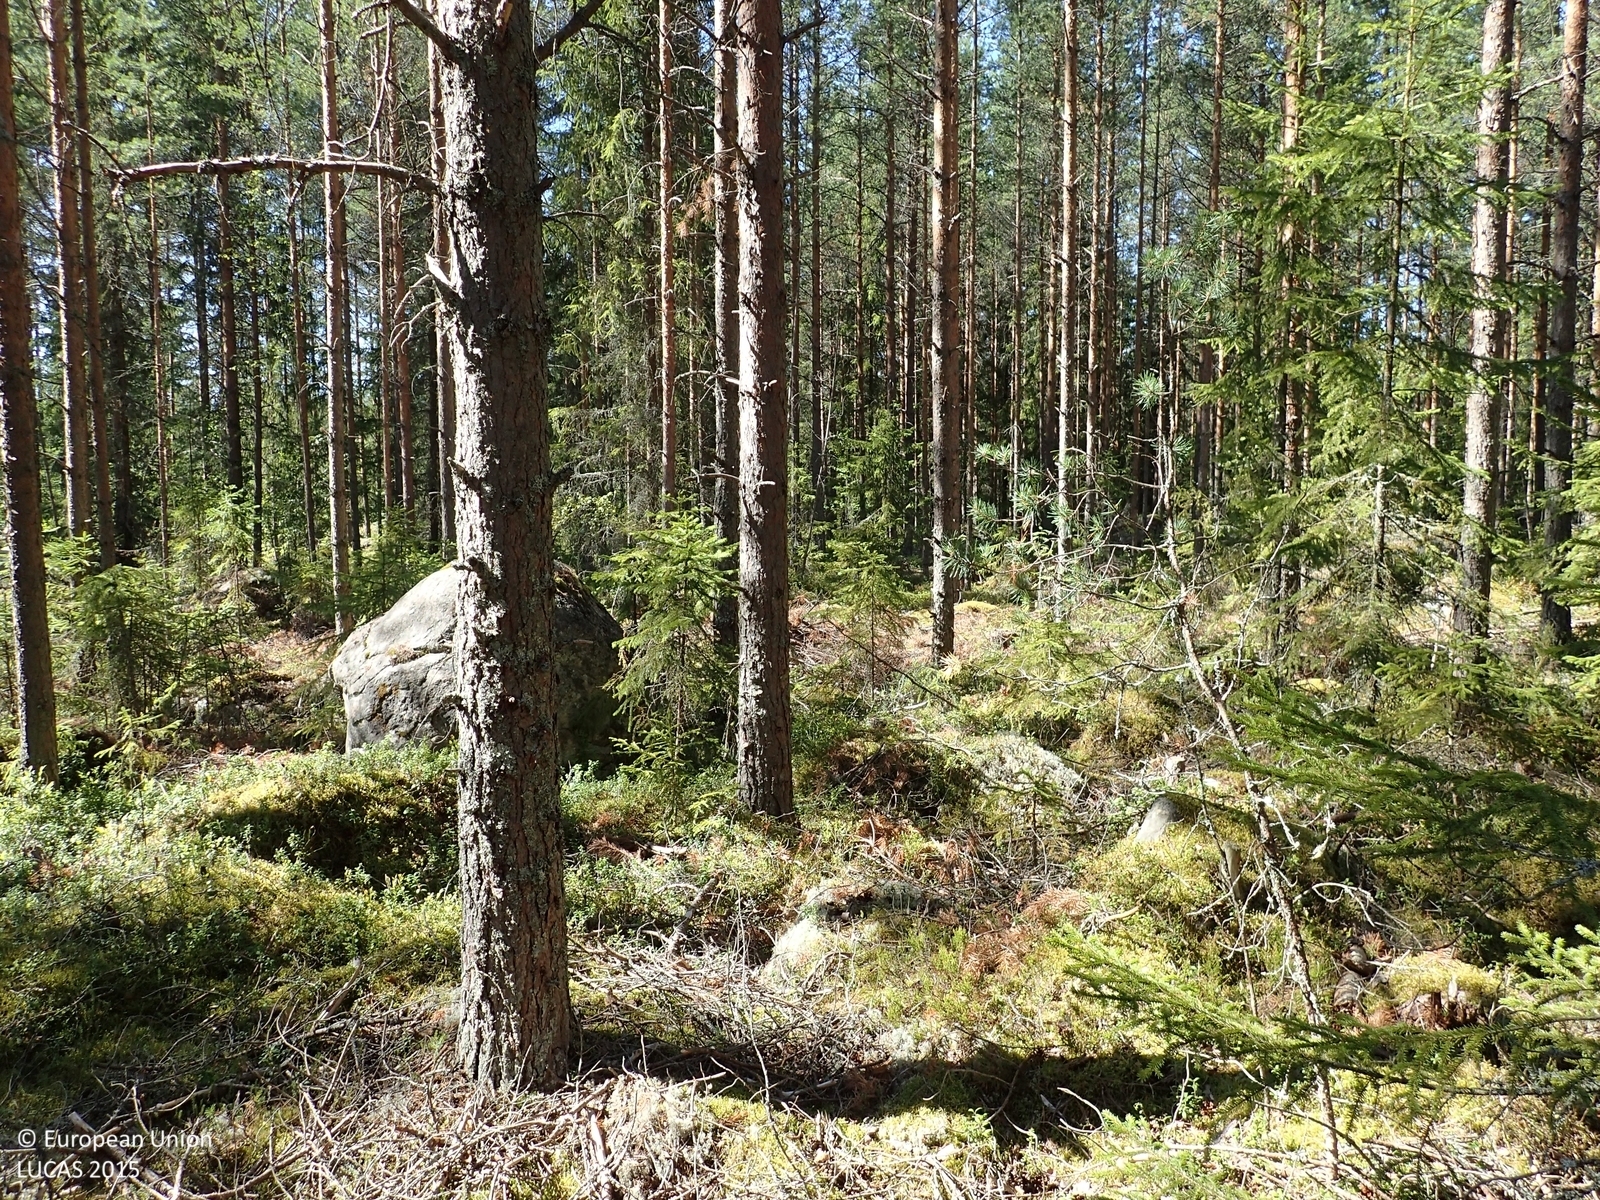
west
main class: Woodland
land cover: Pine dominated coniferous woodland
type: boreal forest
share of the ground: 50 - 75 %
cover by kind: coniferous forest trees 55 %, shrubs 25 %, lichens and mosses 15 %, broadleaved forest trees 5 %
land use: Forestry
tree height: > 5 m
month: August
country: FI
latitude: 62.5418
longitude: 22.5559
